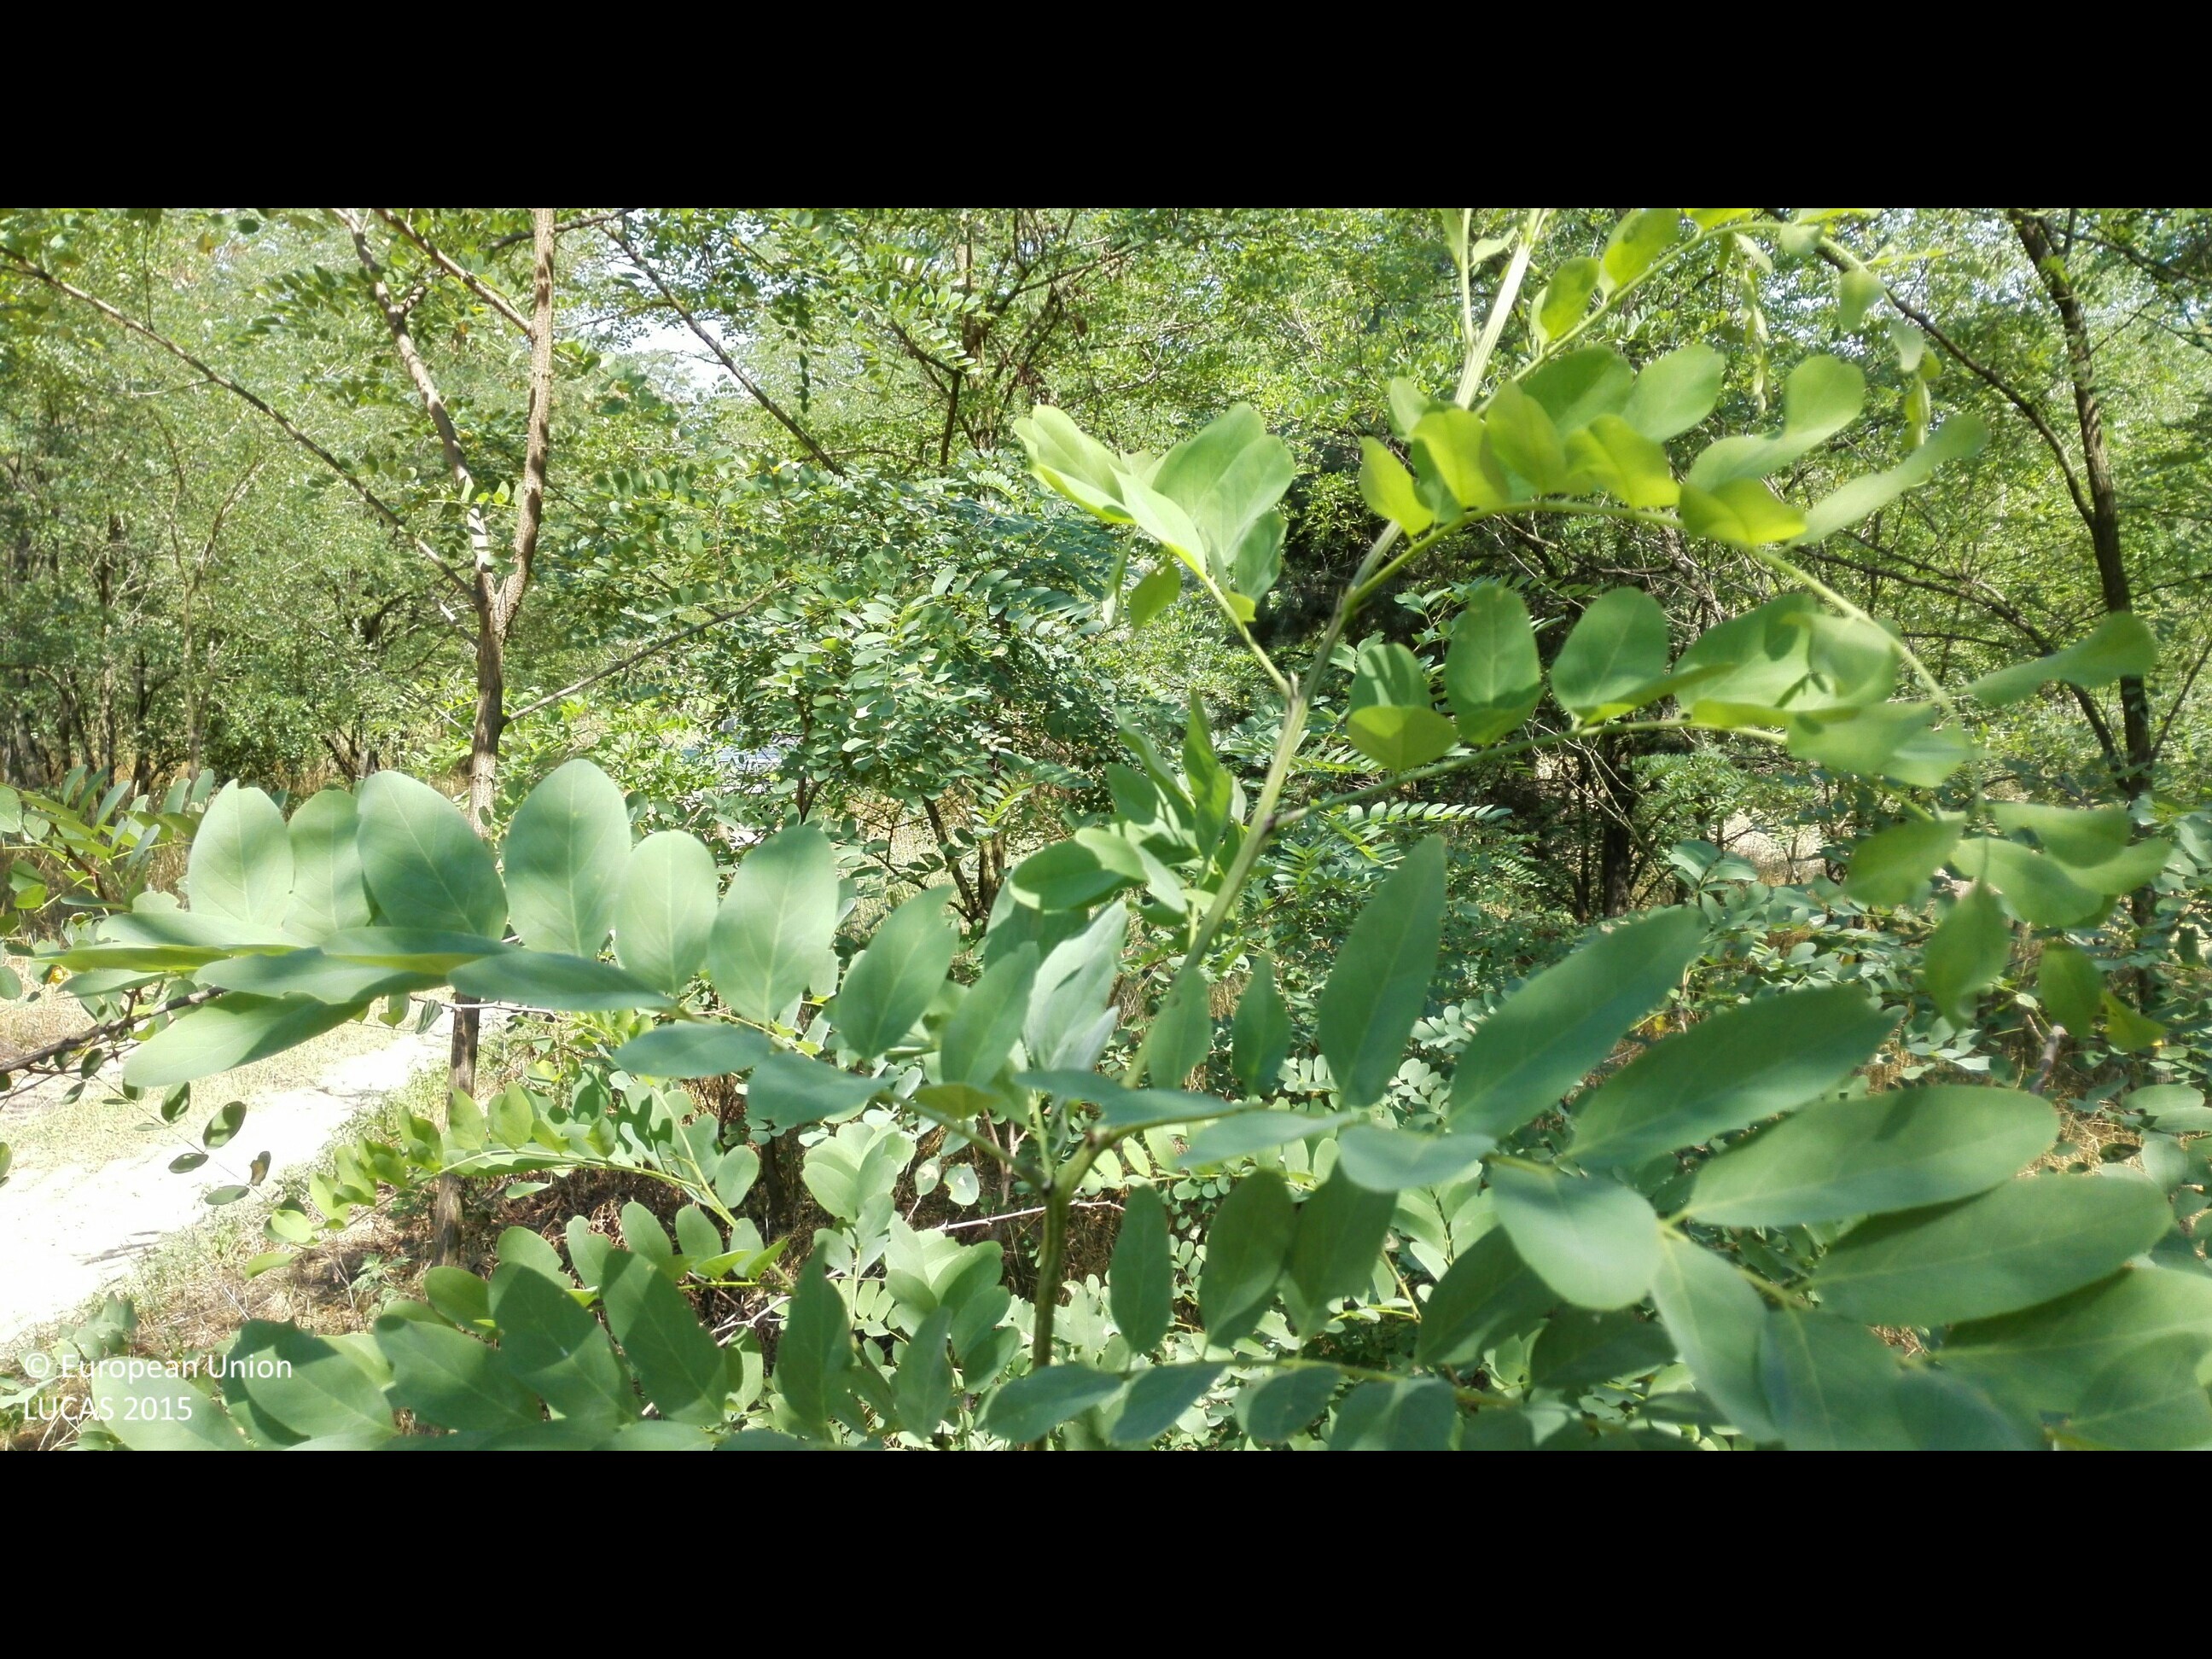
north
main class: Woodland
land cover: Broadleaved woodland
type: exotic forest
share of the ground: > 75 %
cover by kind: broadleaved forest trees 85 %, coniferous forest trees 10 %, herbaceous plants 5 %
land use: Forestry
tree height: > 5 m
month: August
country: HU
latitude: 47.5950
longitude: 22.0601
